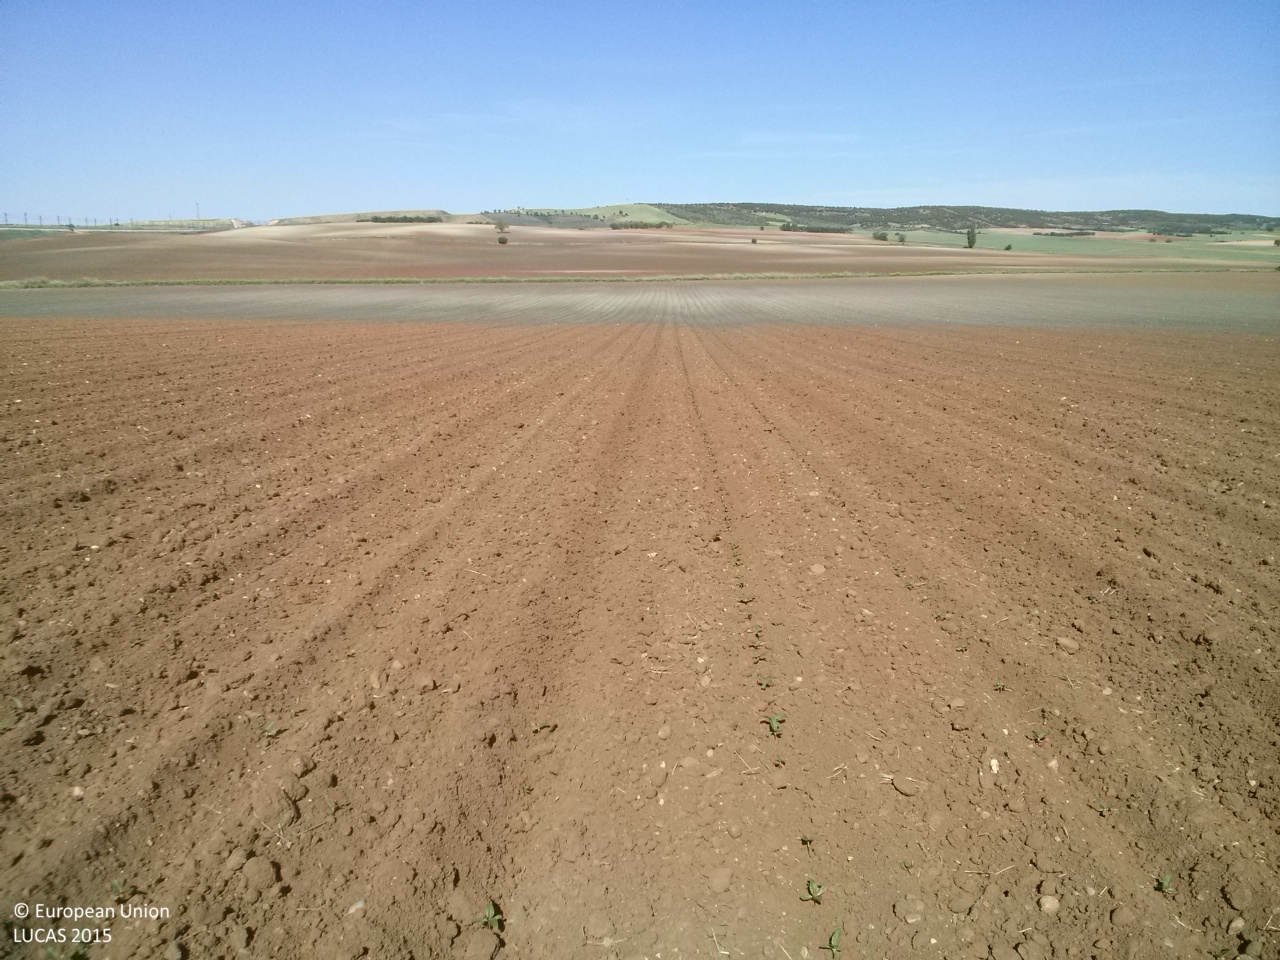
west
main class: Cropland
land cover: Sunflower
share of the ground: < 10 %
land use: Agriculture (excluding fallow land and kitchen gardens)
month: May
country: ES
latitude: 40.0280
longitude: -2.8062
